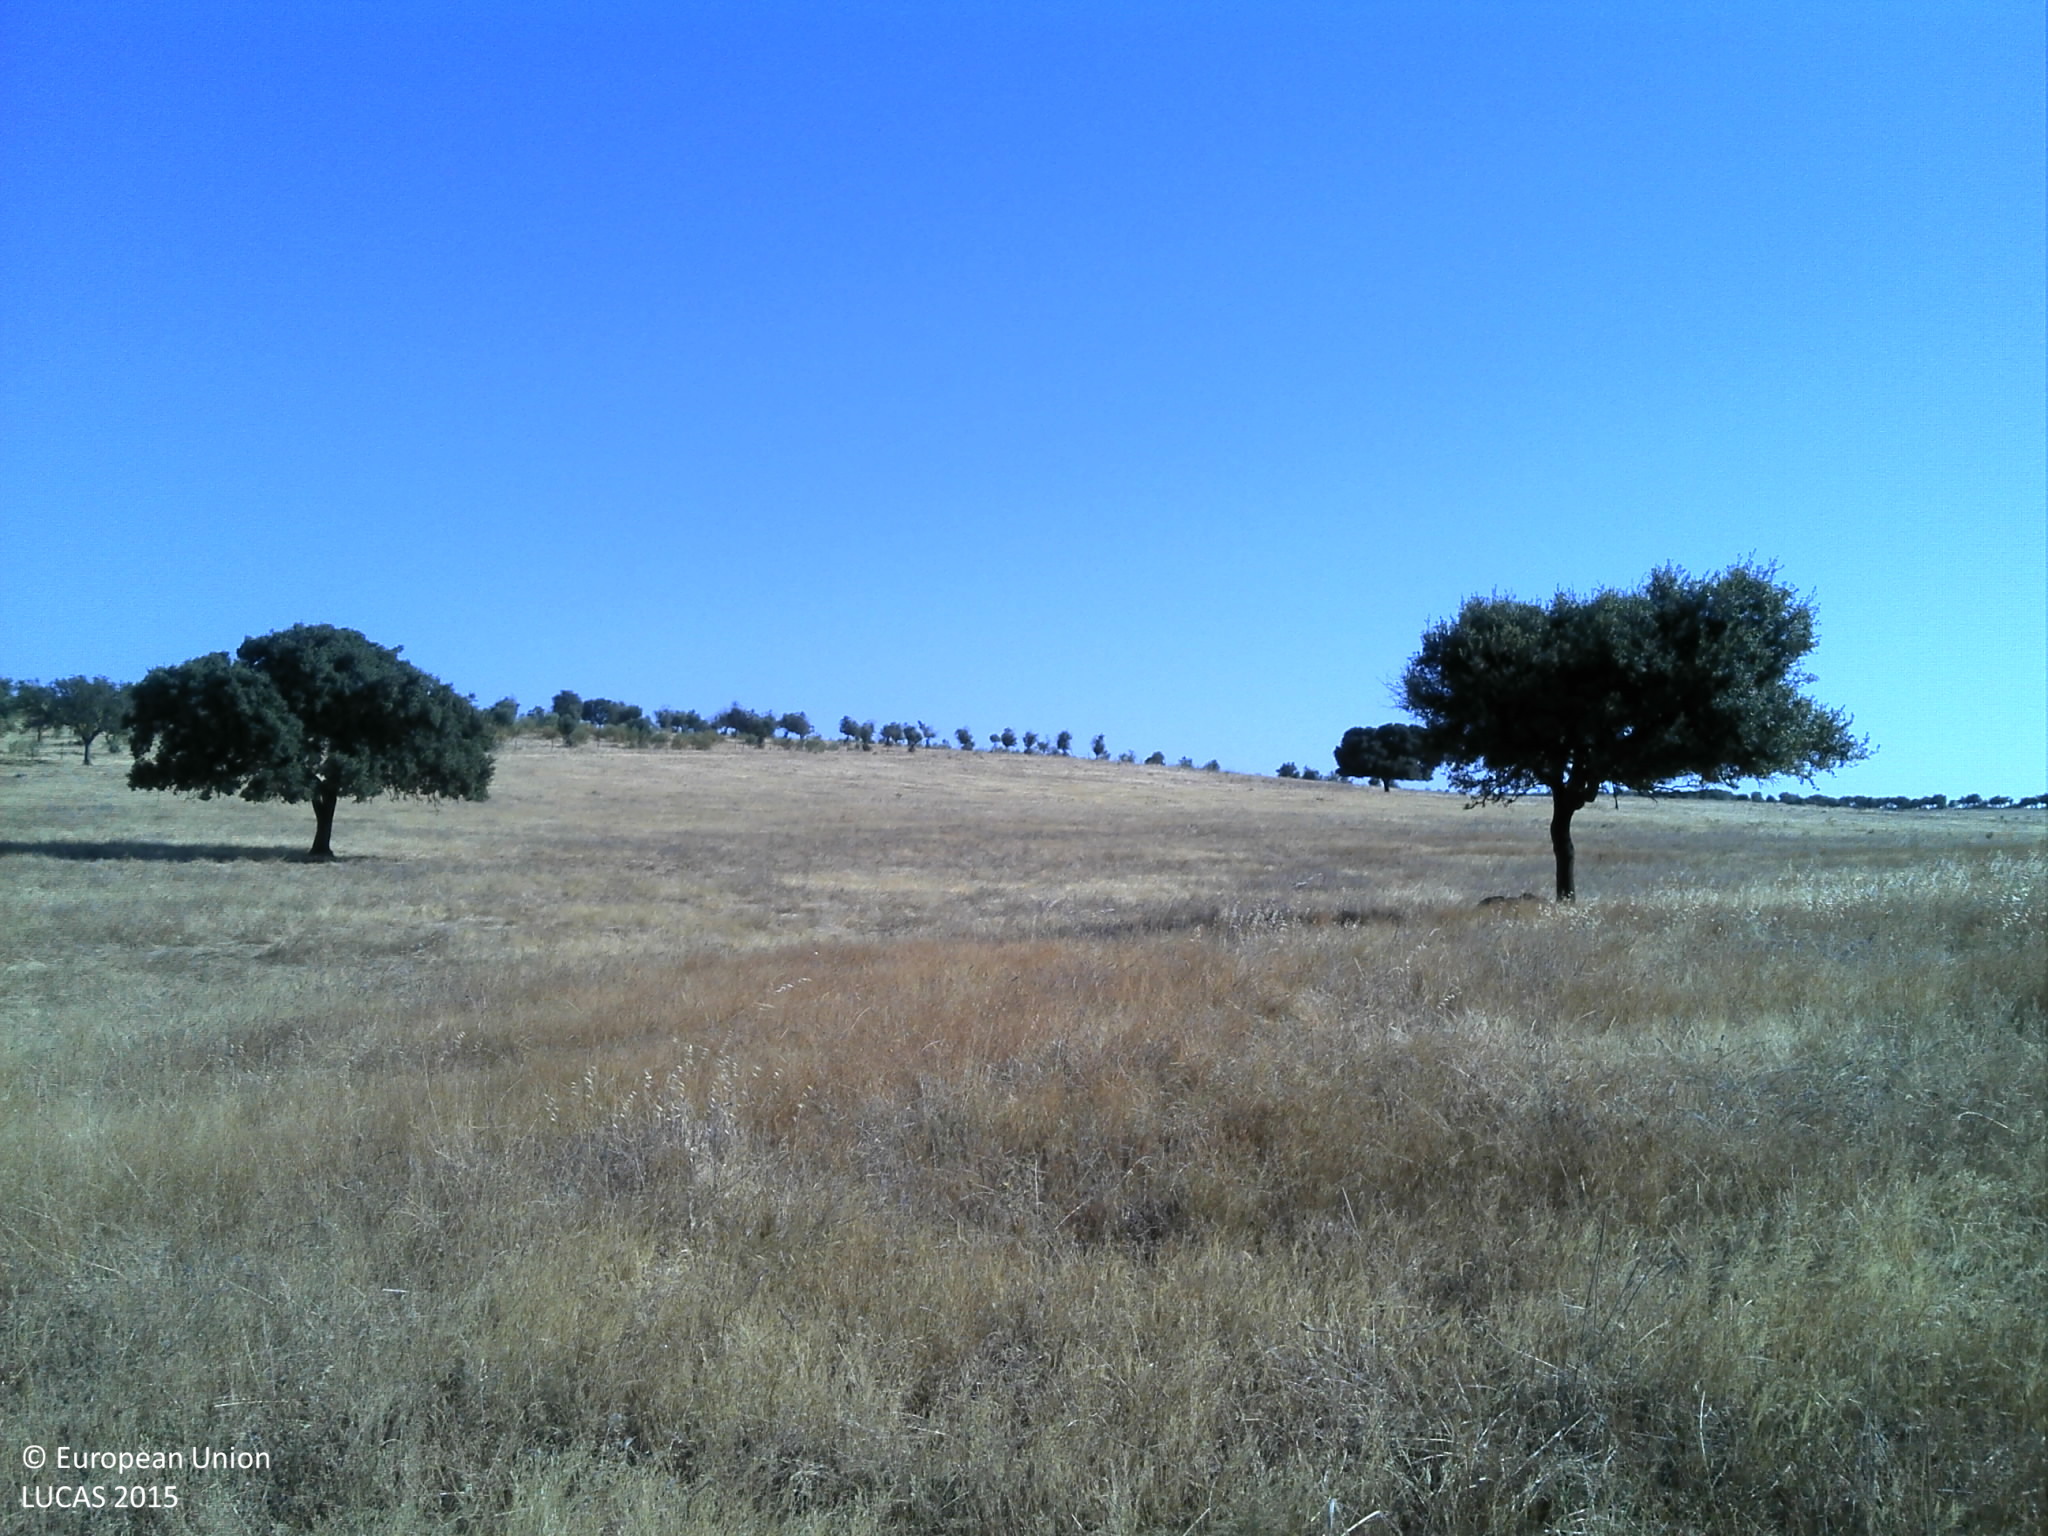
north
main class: Grassland
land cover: Grassland without tree/shrub cover
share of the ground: 50 - 75 %
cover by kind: herbaceous plants 60 %, unconsolidated bare surface 40 %
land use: Agriculture (excluding fallow land and kitchen gardens)
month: July
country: PT
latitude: 39.0450
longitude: -7.4257
